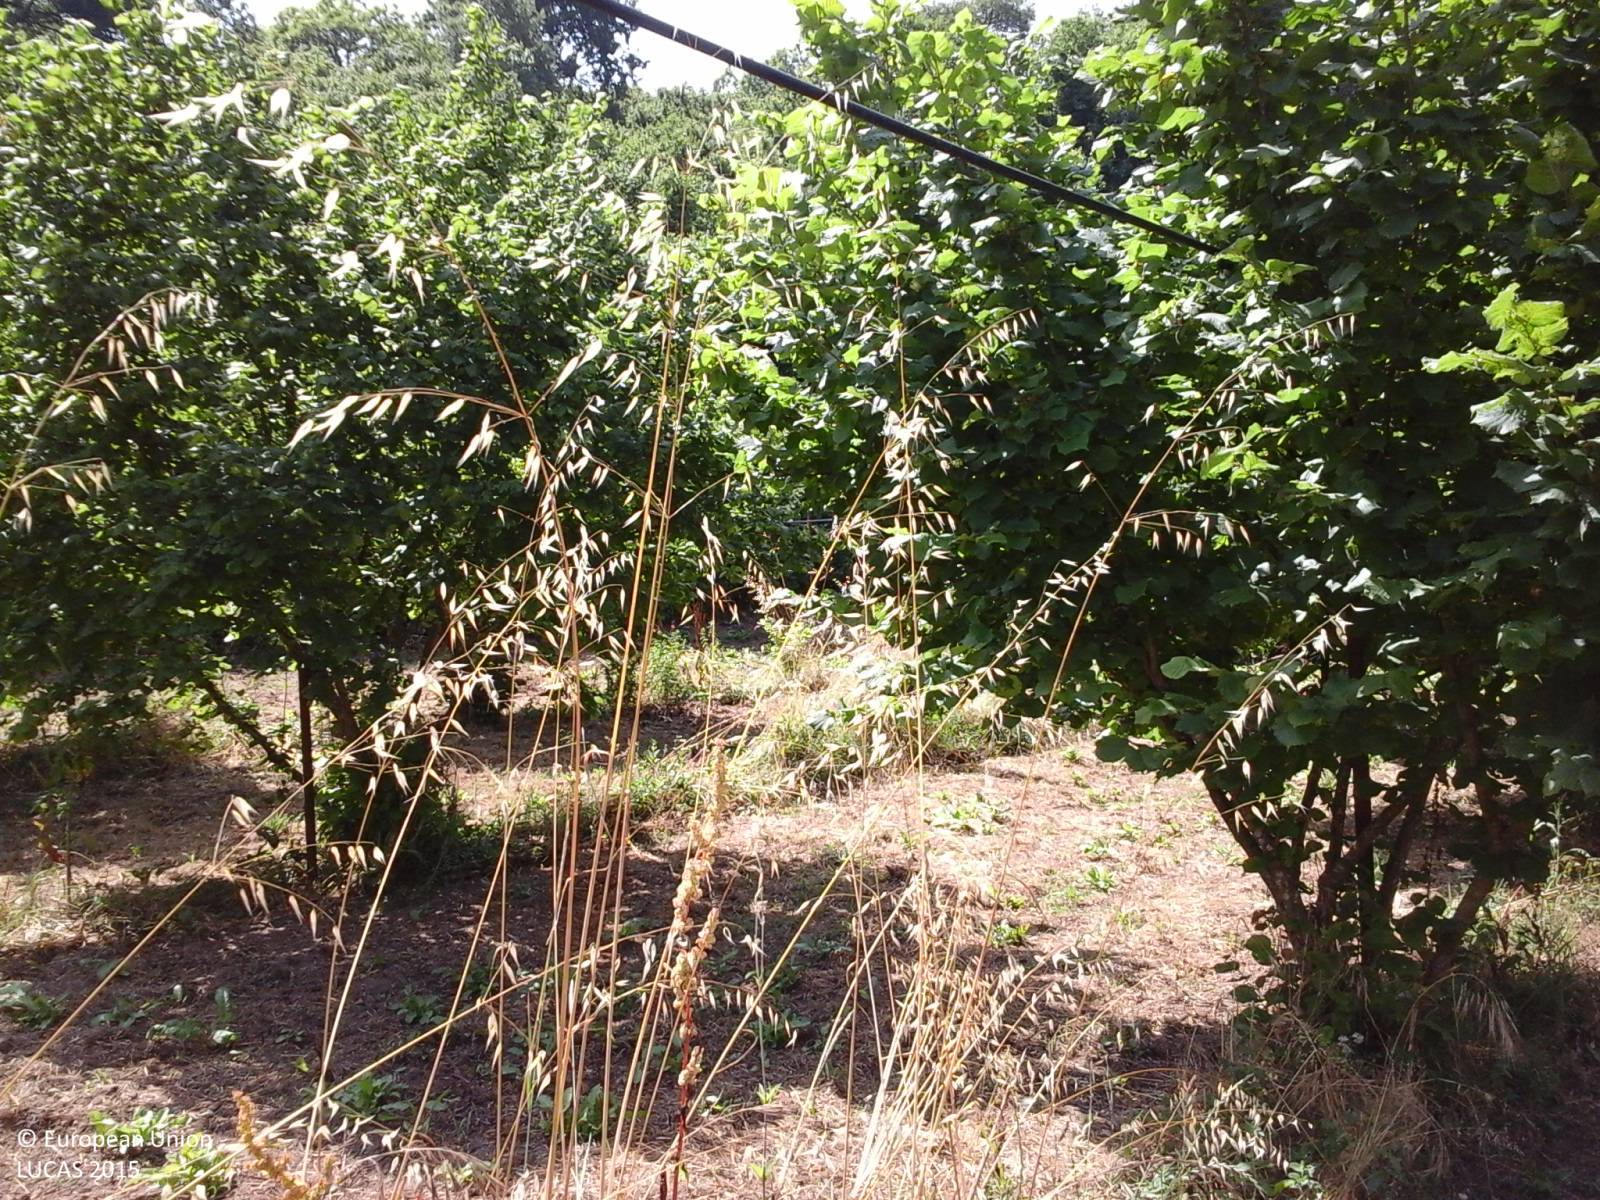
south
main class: Cropland
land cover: Nuts trees
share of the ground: > 75 %
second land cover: Grassland without tree/shrub cover
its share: > 75 %
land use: Agriculture (excluding fallow land and kitchen gardens)
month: June
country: IT
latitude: 42.4305
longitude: 12.2411
